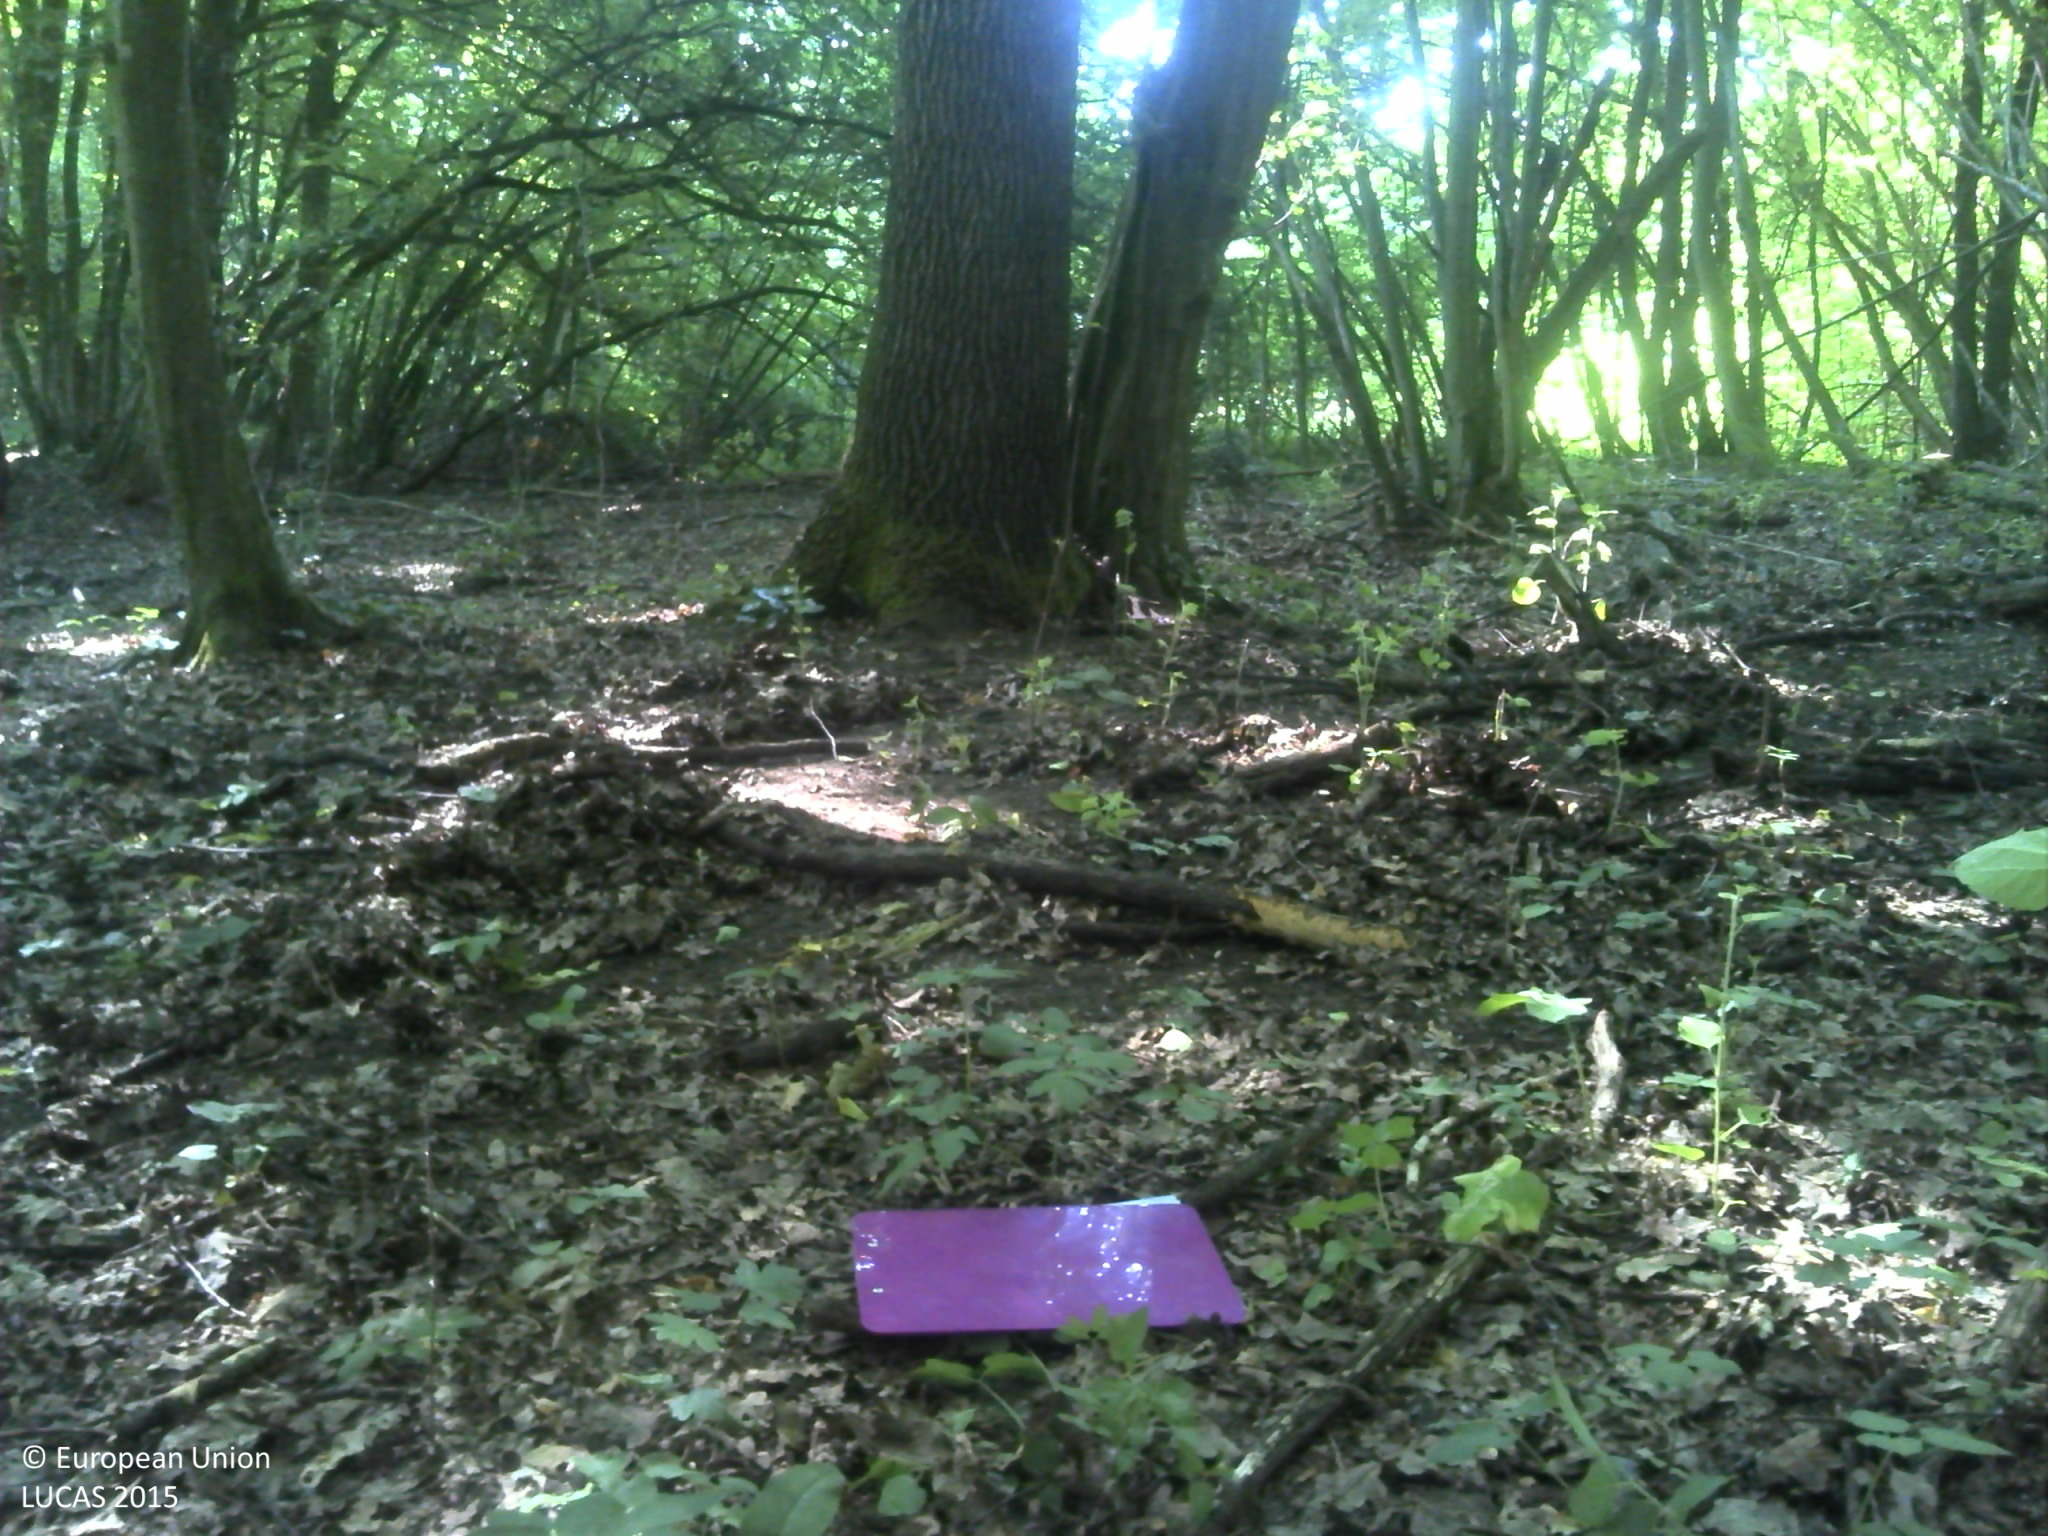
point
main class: Woodland
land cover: Broadleaved woodland
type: acidophilous oak and oak-birch forest
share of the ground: > 75 %
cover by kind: broadleaved forest trees 90 %, shrubs 5 %, herbaceous plants 5 %
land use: Forestry
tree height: > 5 m
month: June
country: HR
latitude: 45.5157
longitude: 17.9017
